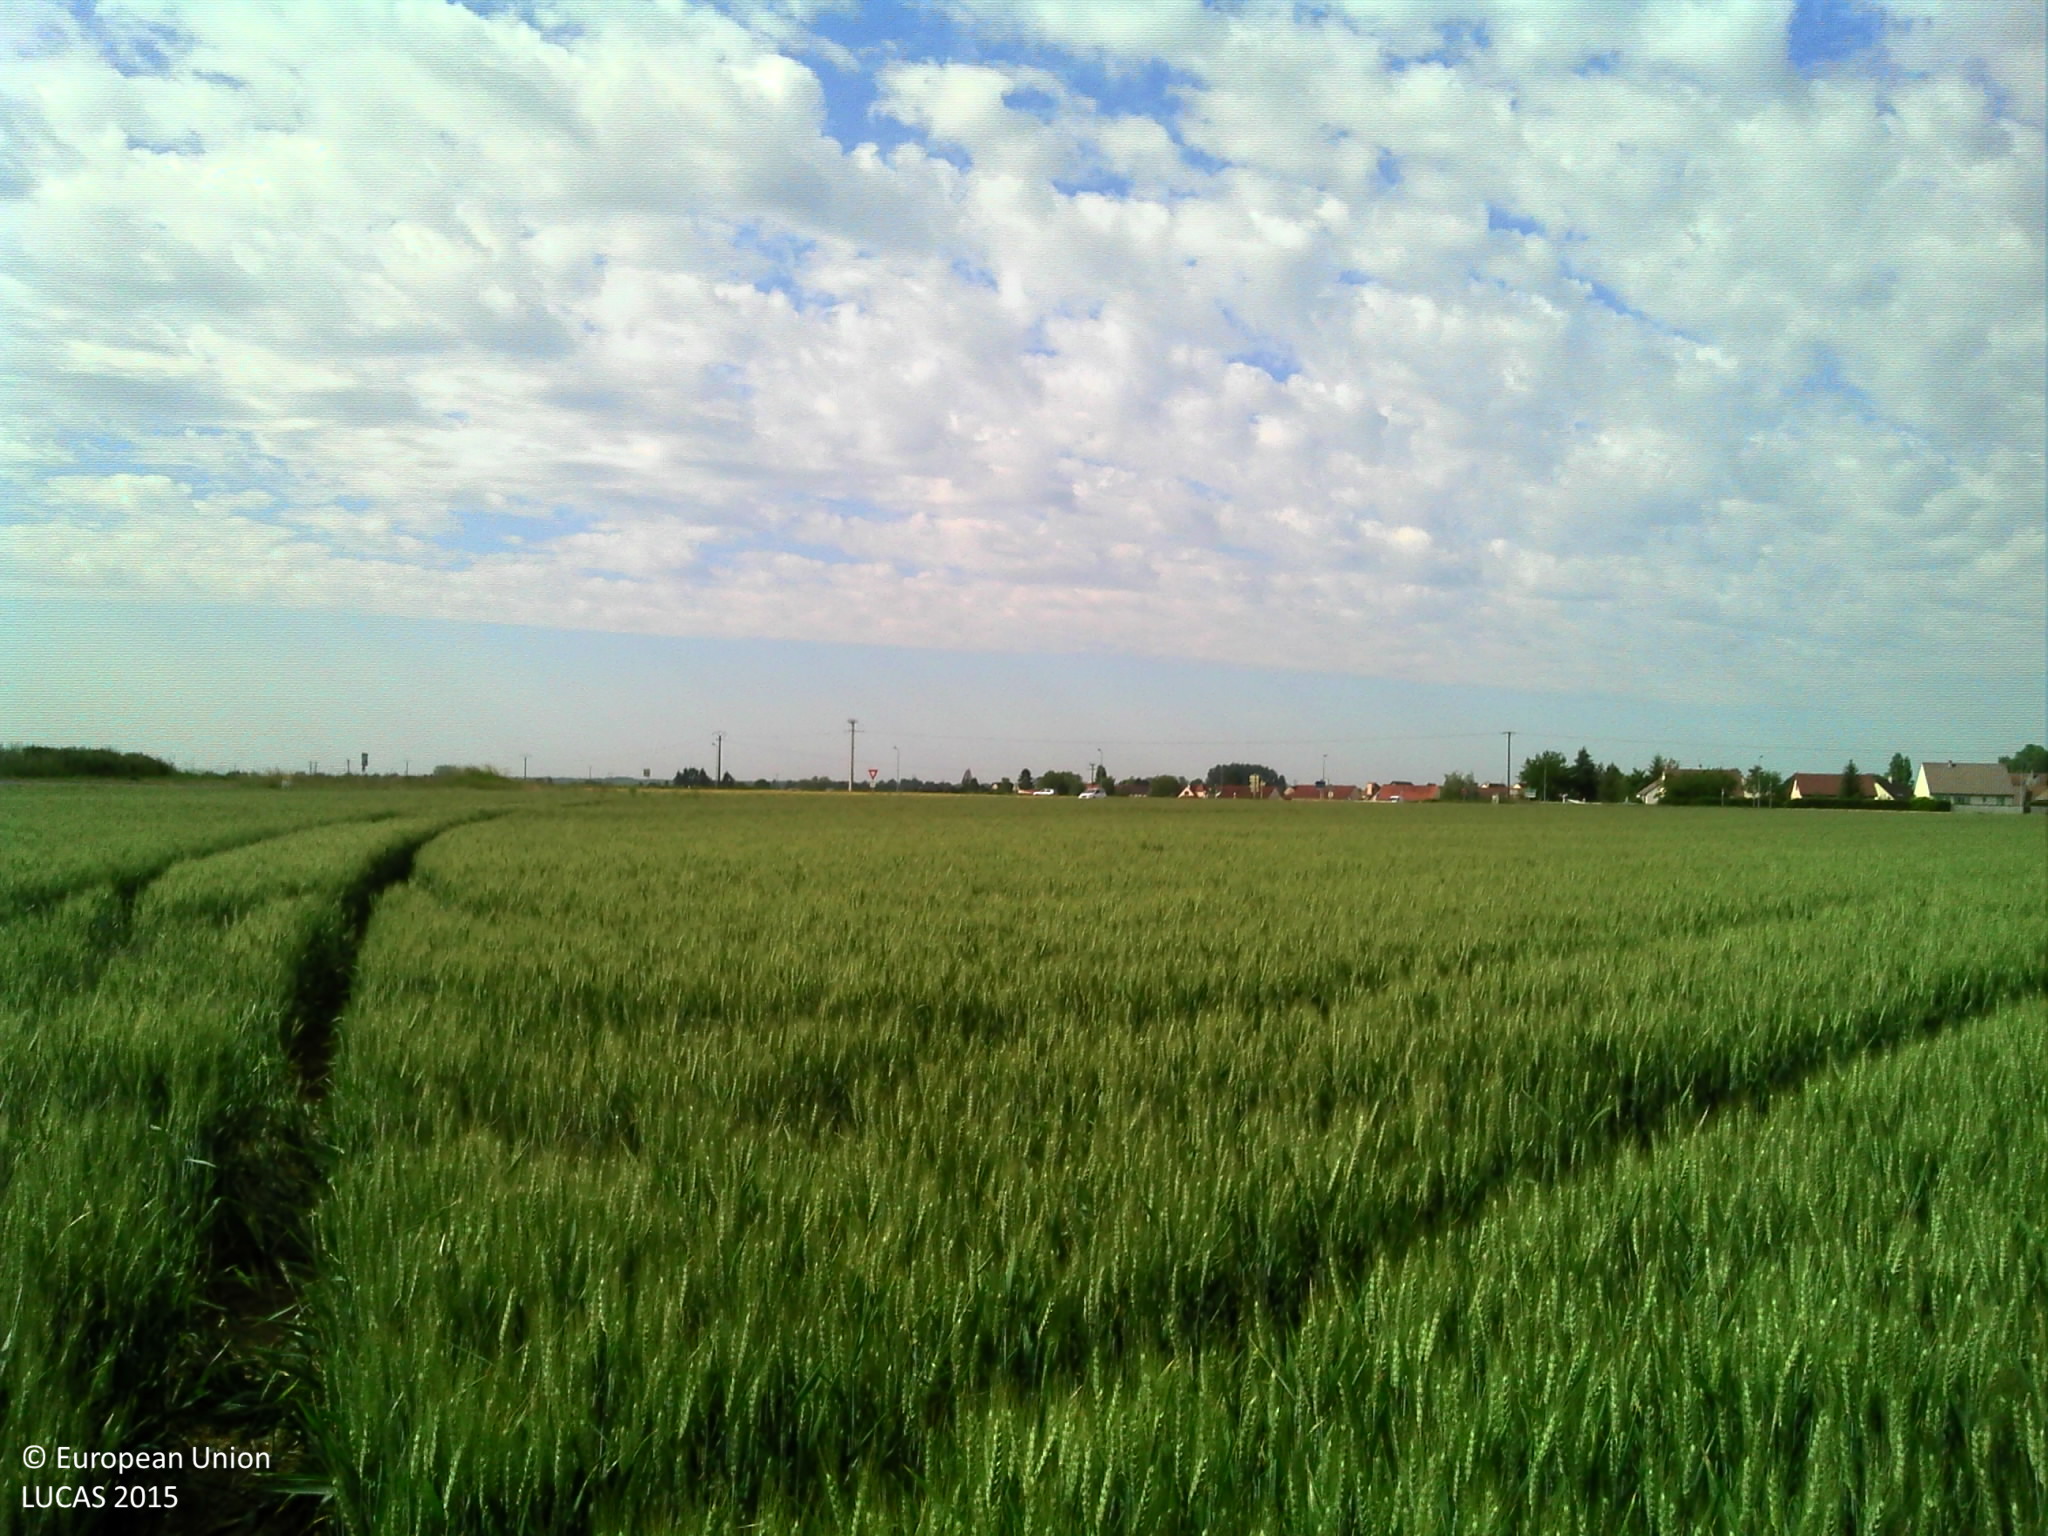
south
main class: Cropland
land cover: Common wheat
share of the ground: > 75 %
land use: Agriculture (excluding fallow land and kitchen gardens)
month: May
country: FR
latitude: 47.2202
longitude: 5.2603
